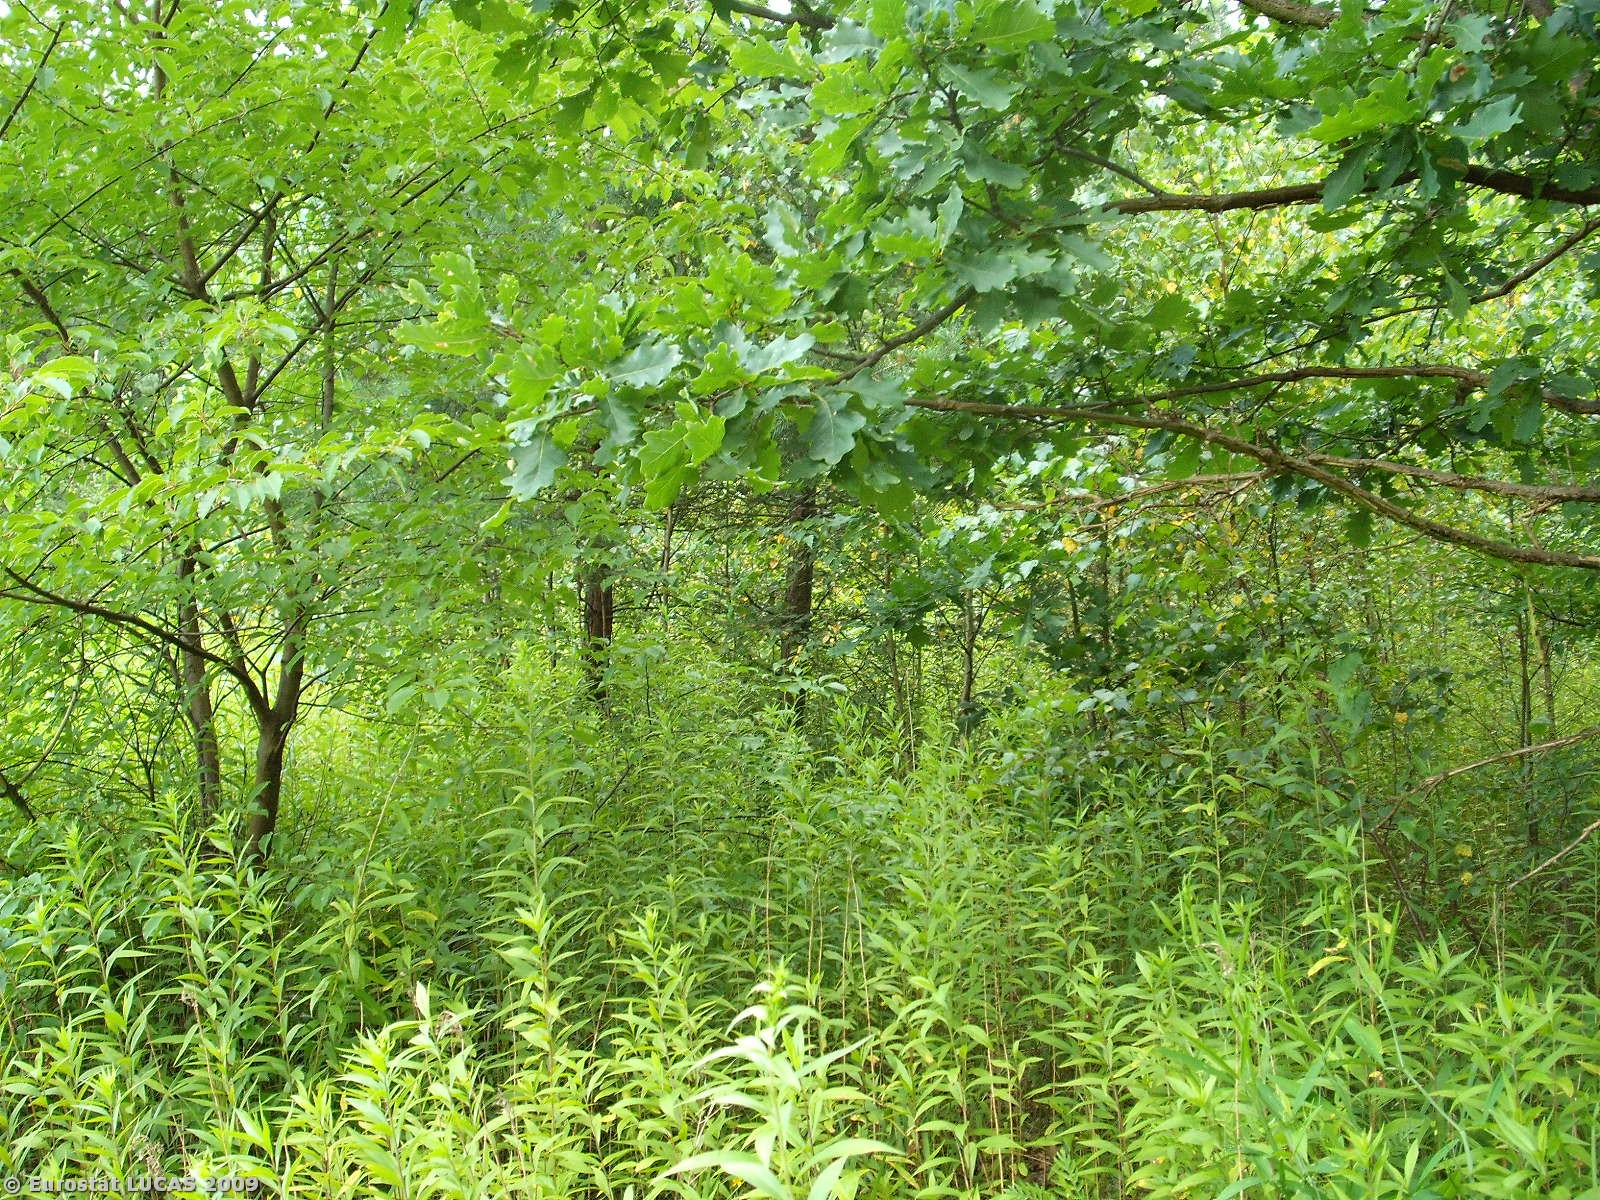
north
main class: Woodland
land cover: Broadleaved woodland
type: mesophytic deciduous forest
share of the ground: 25 - 50 %
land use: Forestry
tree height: > 5 m
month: July
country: PL
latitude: 52.1161
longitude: 21.2191
